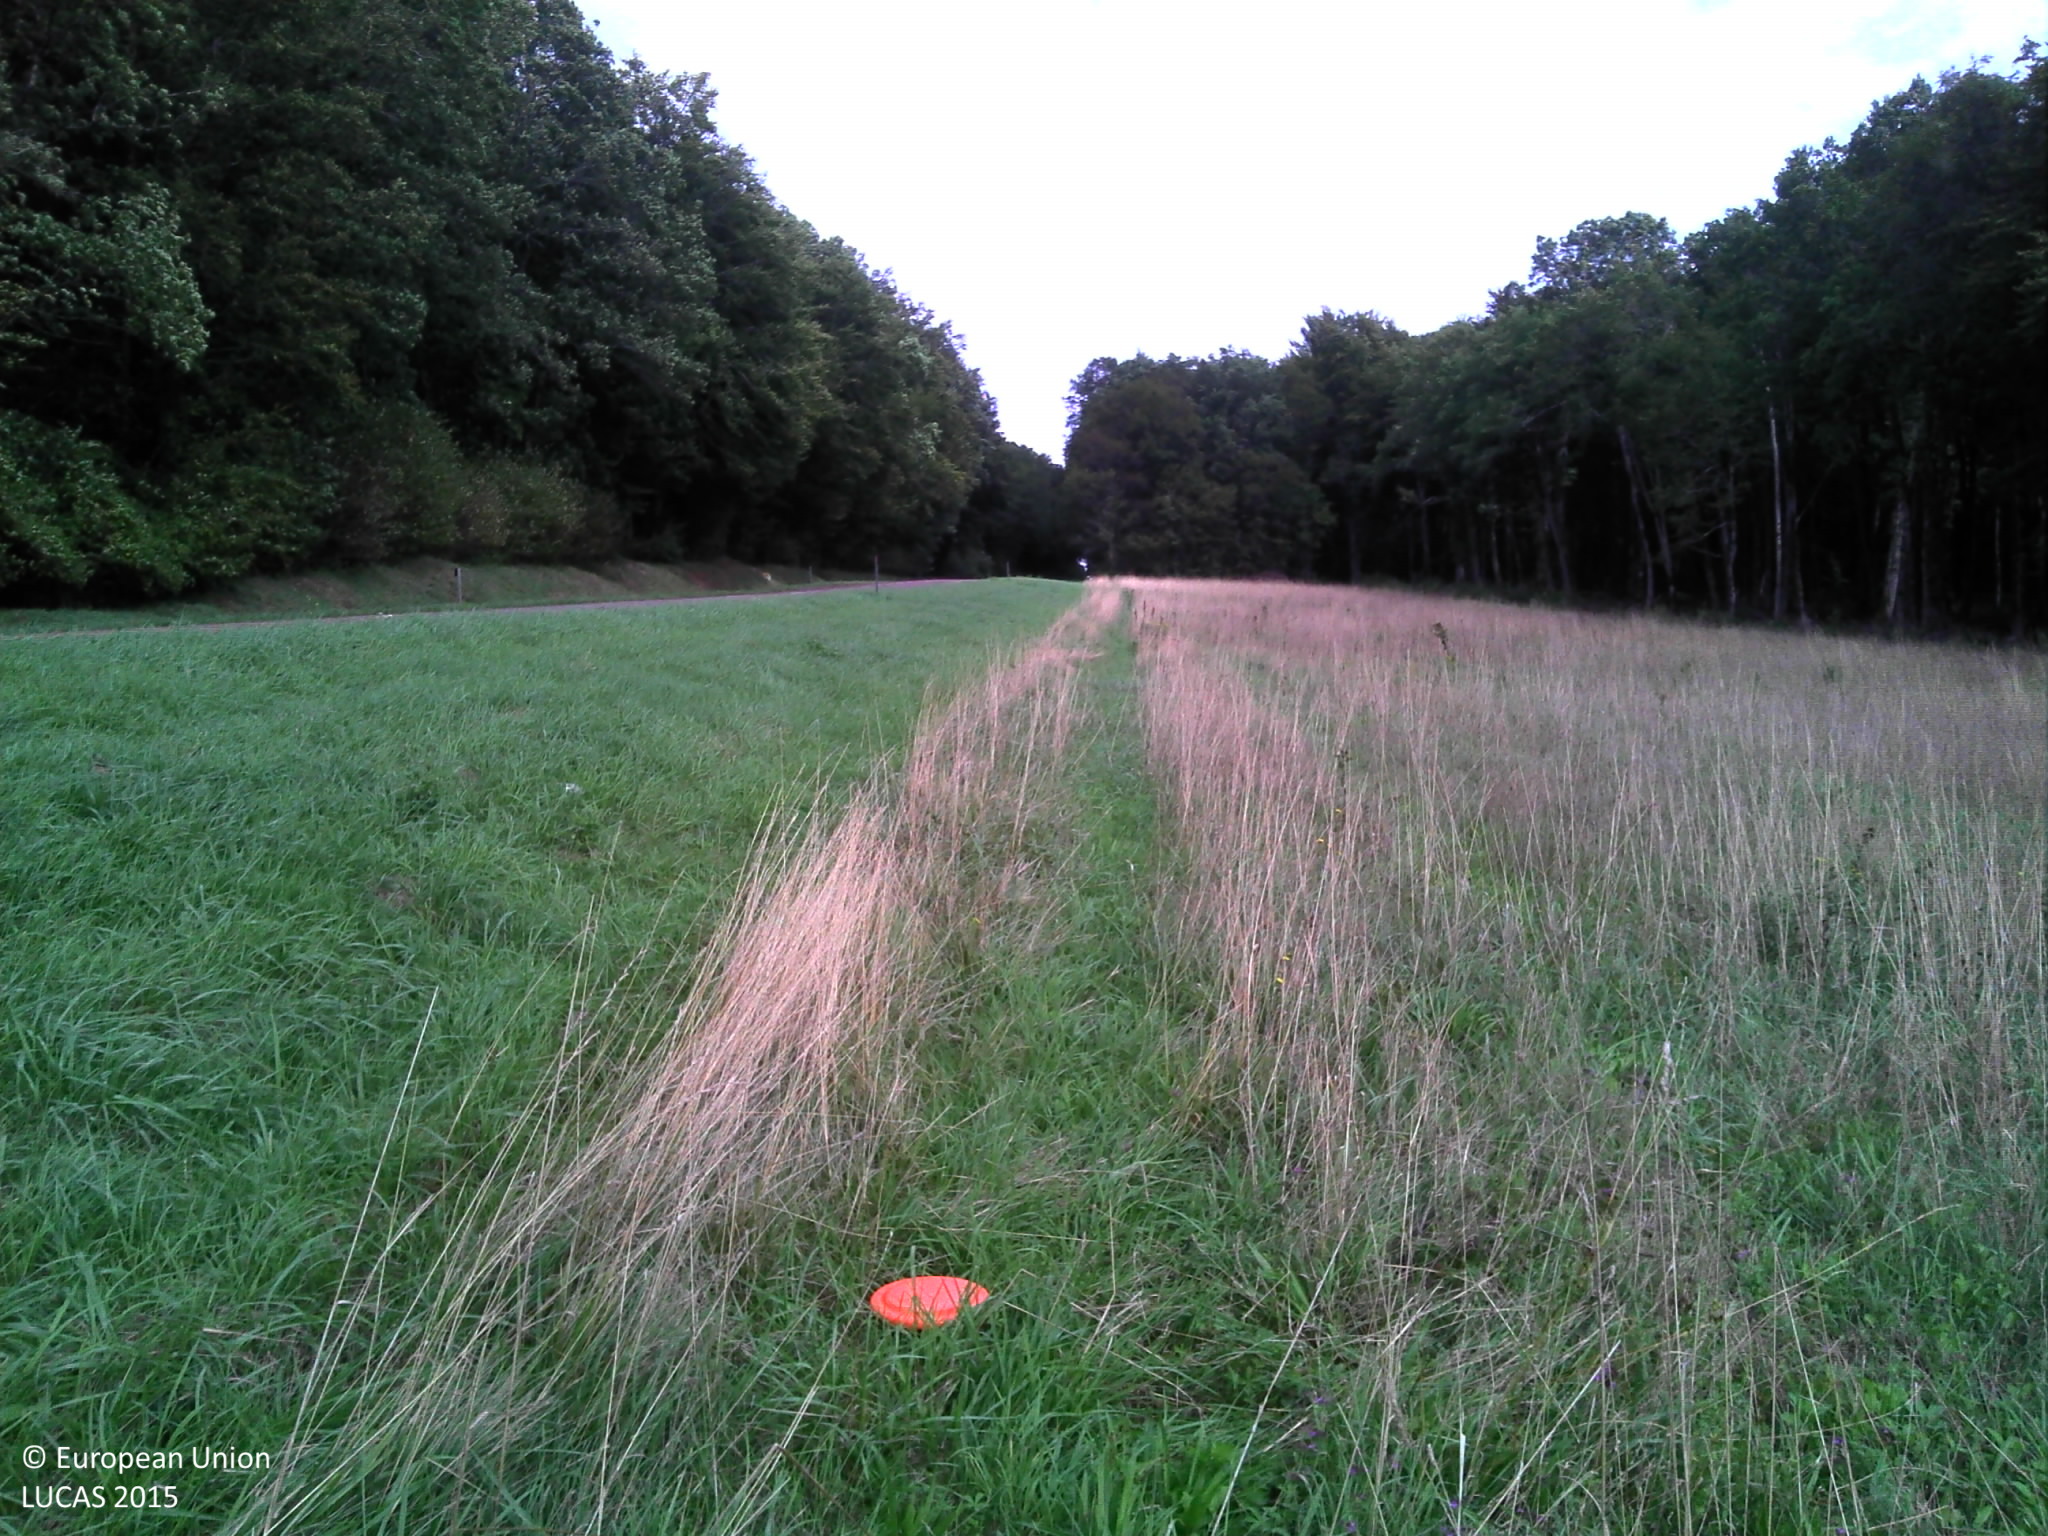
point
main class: Grassland
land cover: Grassland without tree/shrub cover
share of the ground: > 75 %
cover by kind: herbaceous plants 100 %
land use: Agriculture (excluding fallow land and kitchen gardens)
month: September
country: FR
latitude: 47.6466
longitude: 4.3674
